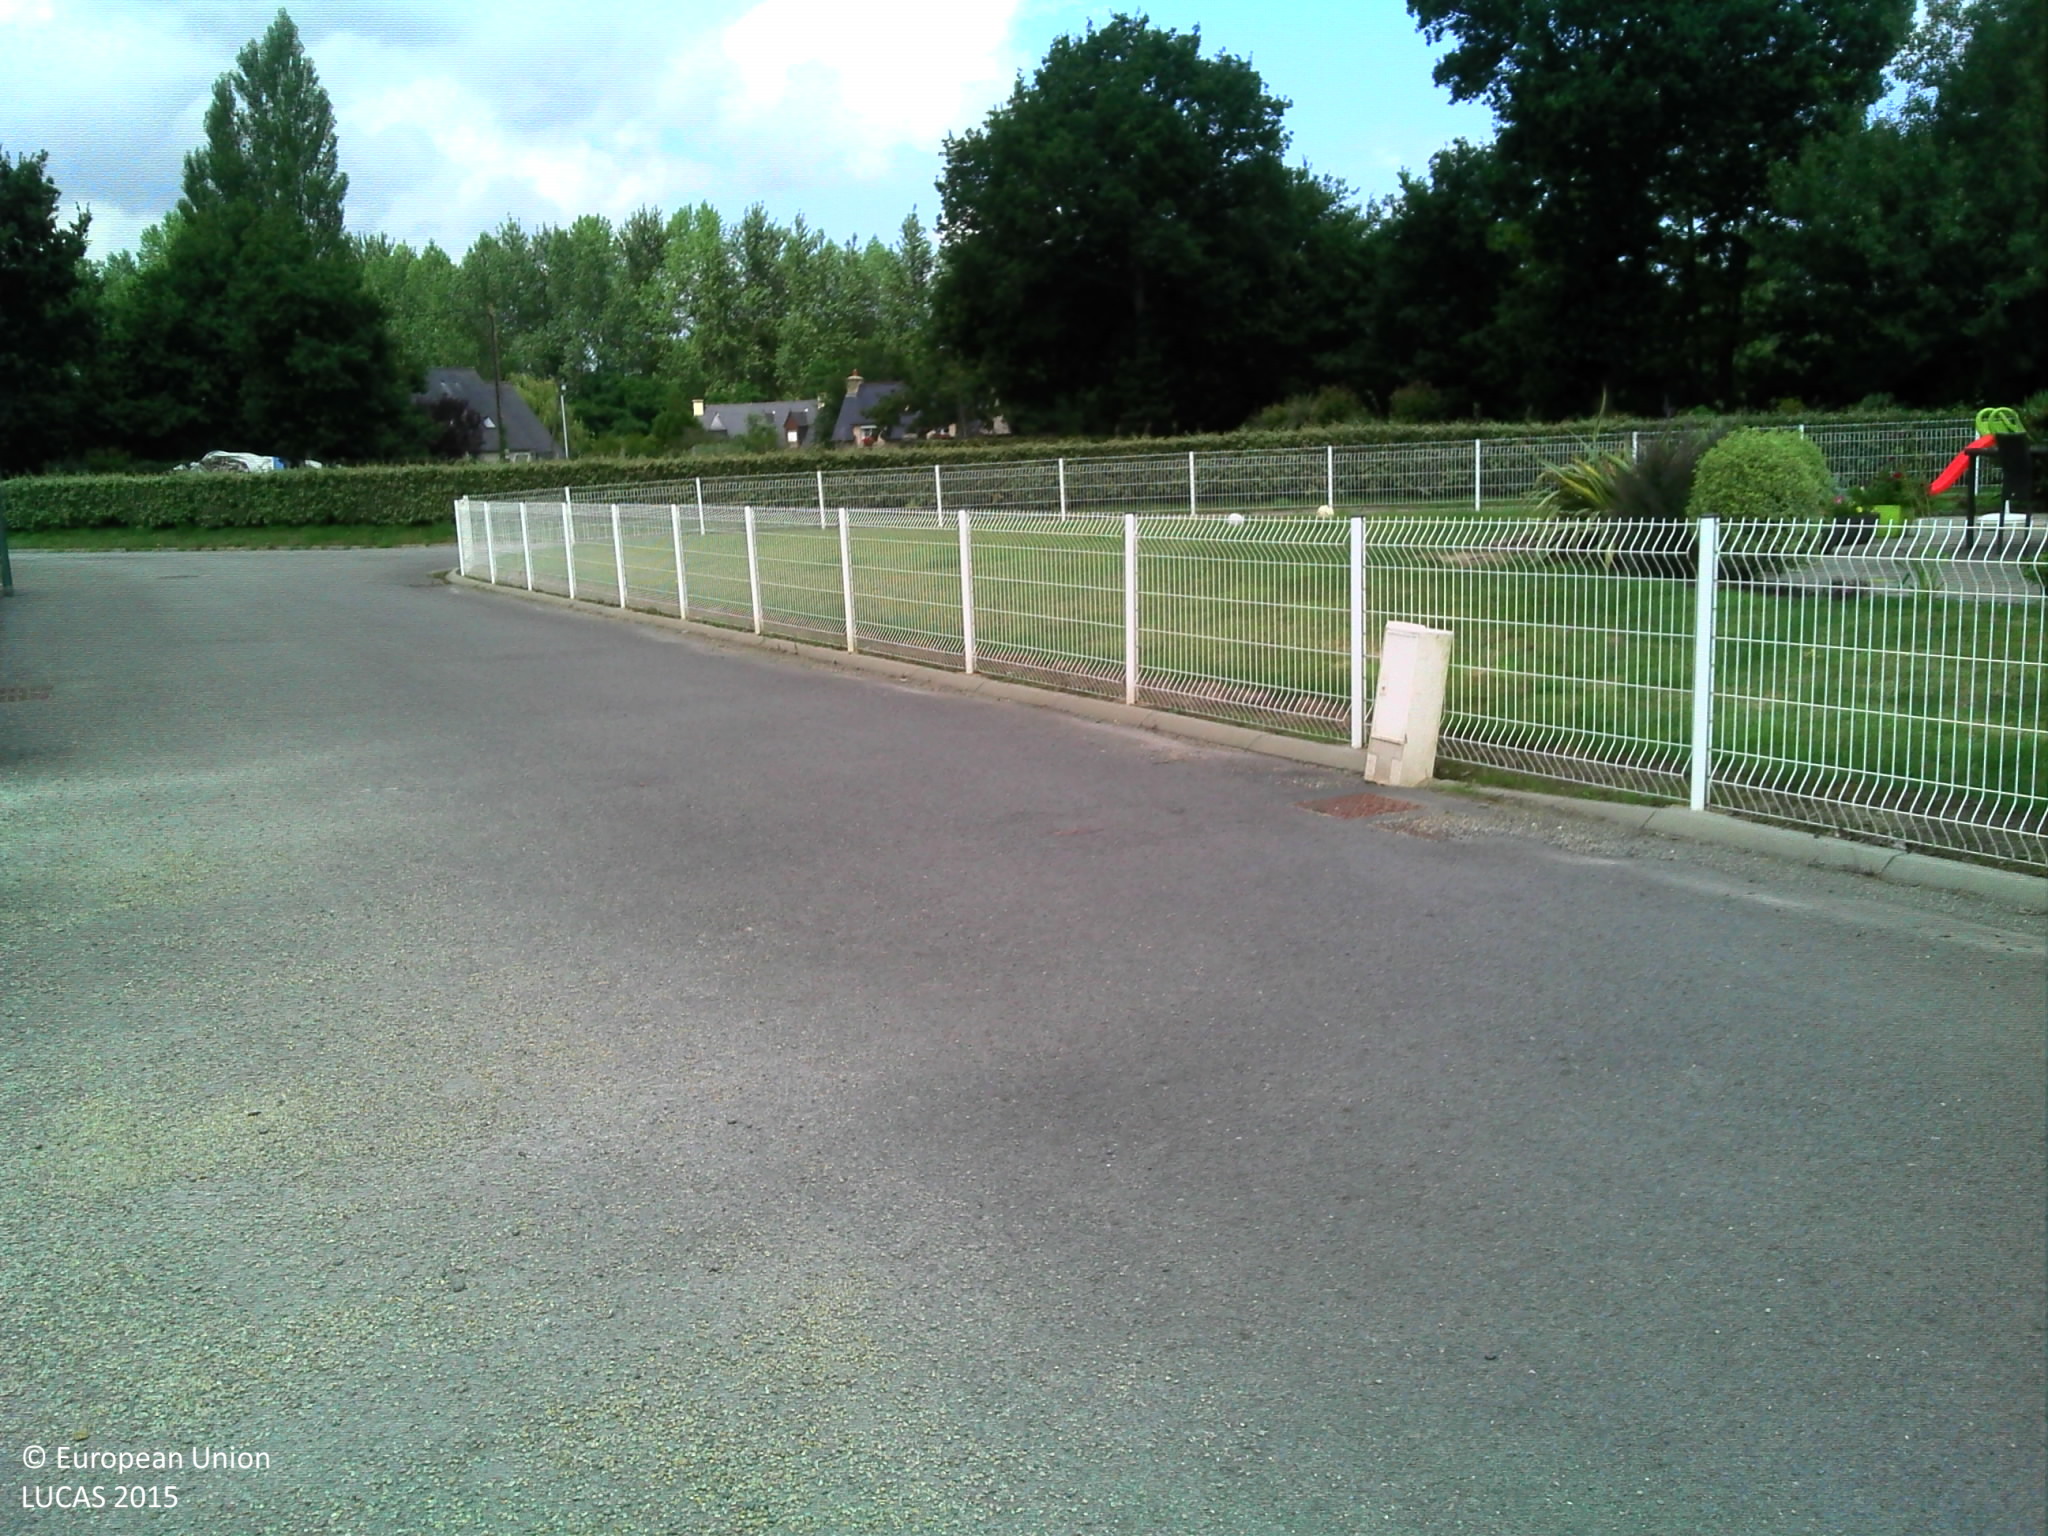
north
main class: Grassland
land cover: Grassland without tree/shrub cover
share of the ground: > 75 %
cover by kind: herbaceous plants 100 %
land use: Residential
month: August
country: FR
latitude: 48.6149
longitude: -3.1629
